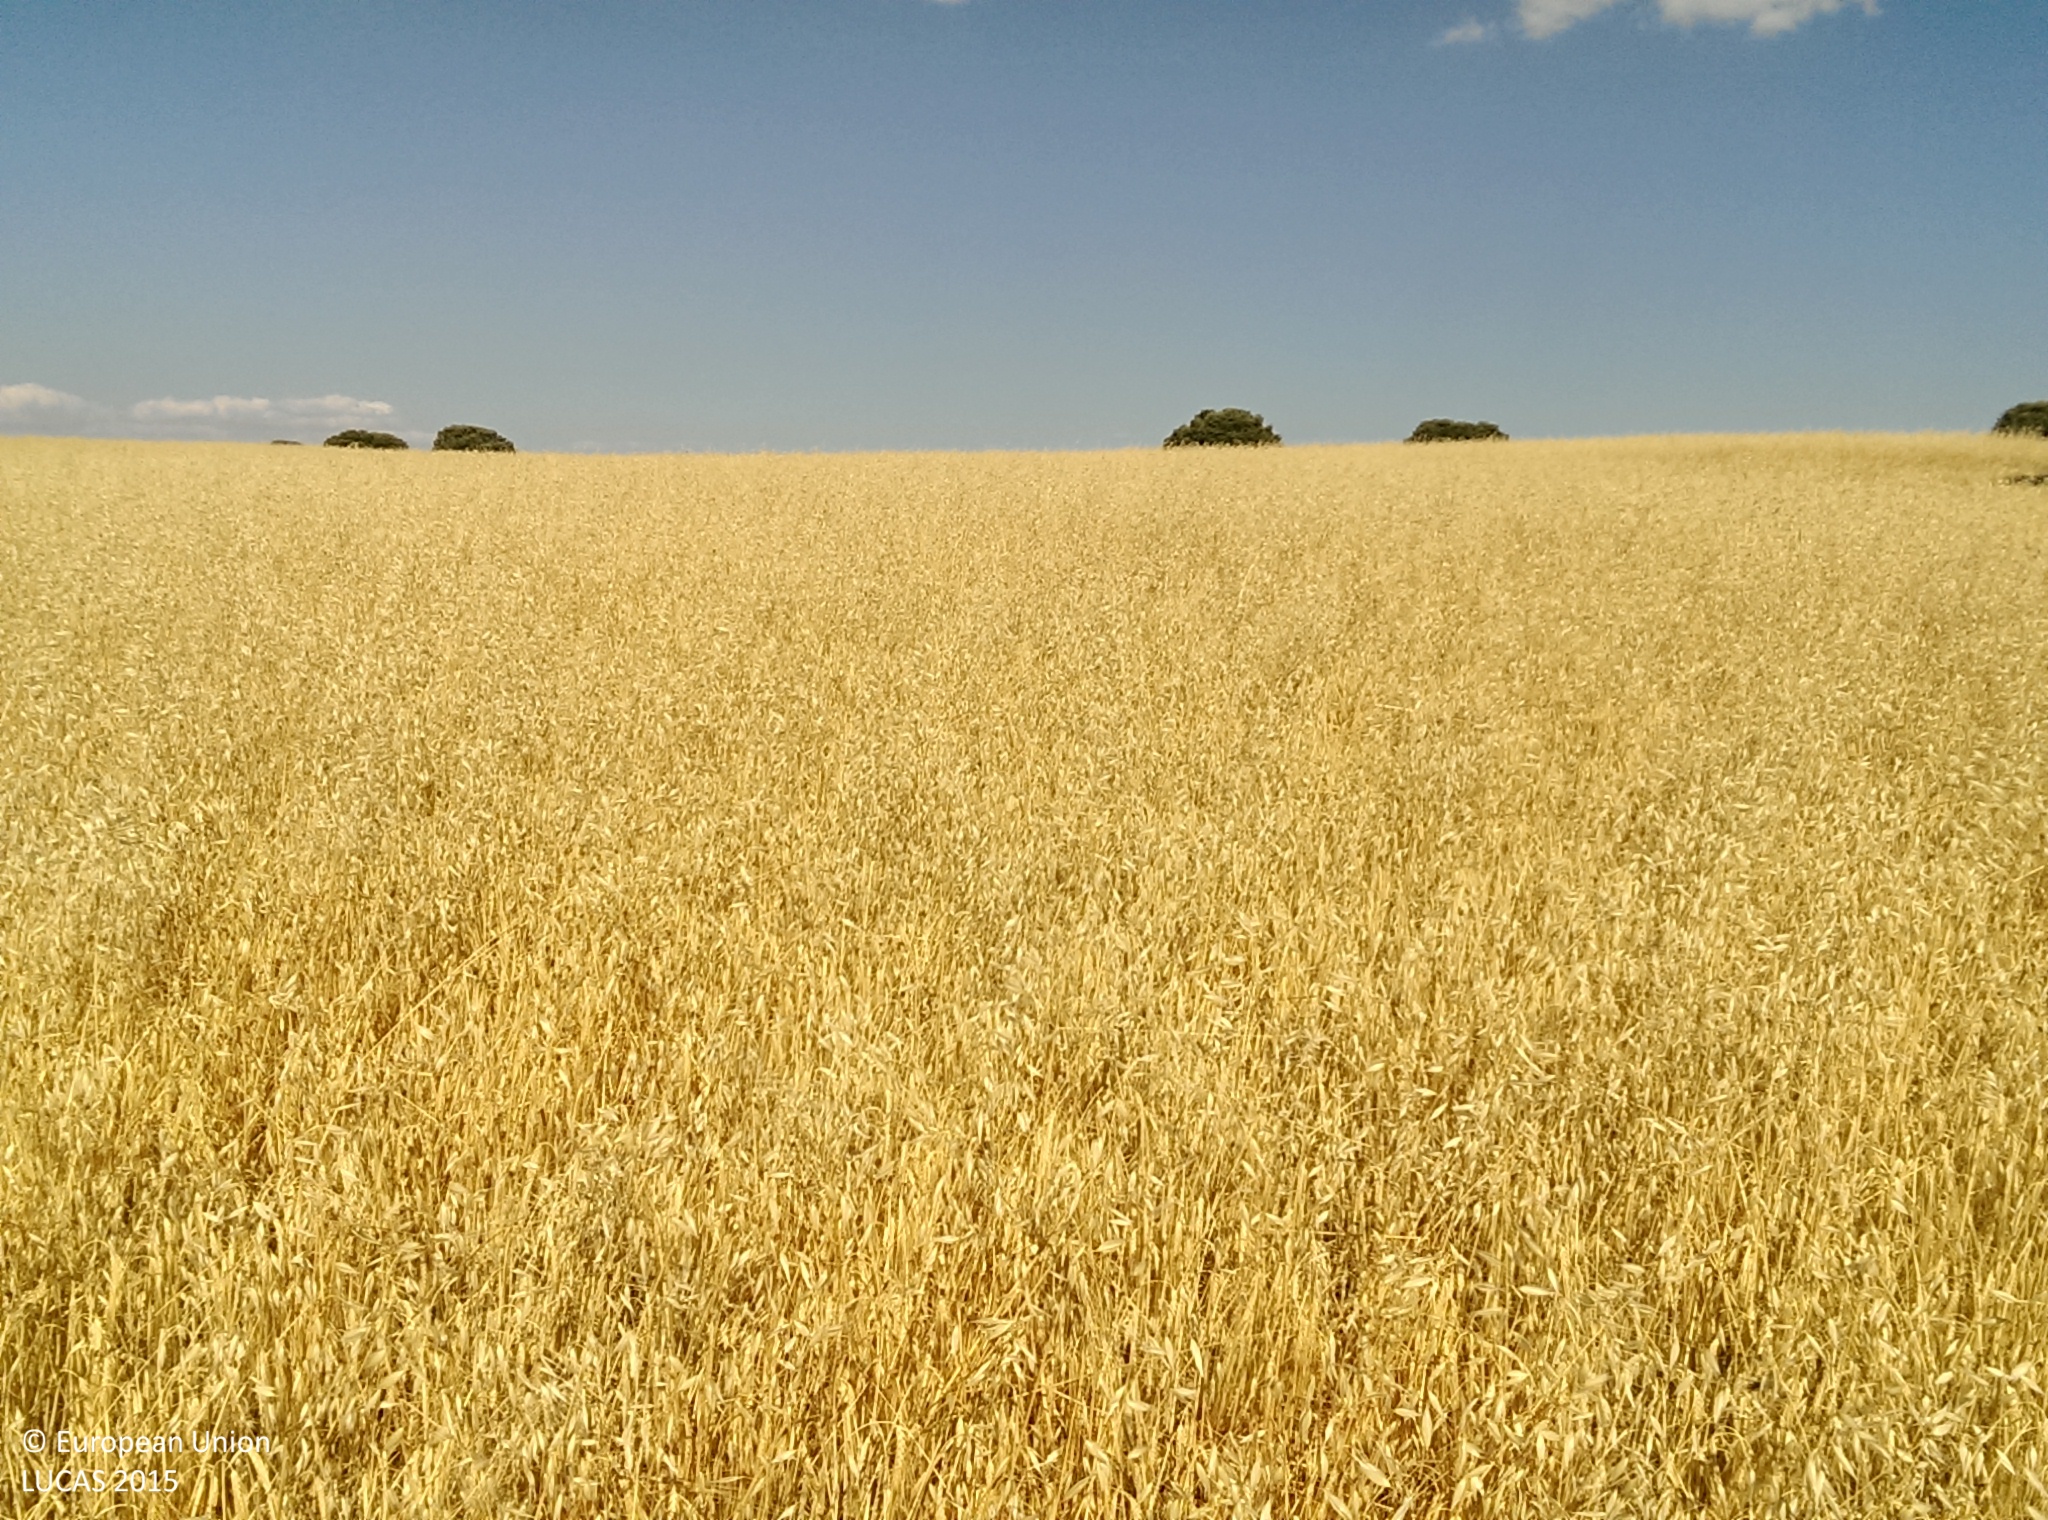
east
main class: Cropland
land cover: Barley
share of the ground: > 75 %
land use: Agriculture (excluding fallow land and kitchen gardens)
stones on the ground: < 10 %
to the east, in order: Barley; Grass margins; Tracks; Grass margins; Other bare soil; Grass margins; Barley
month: June
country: ES
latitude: 37.5441
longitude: -3.2911
